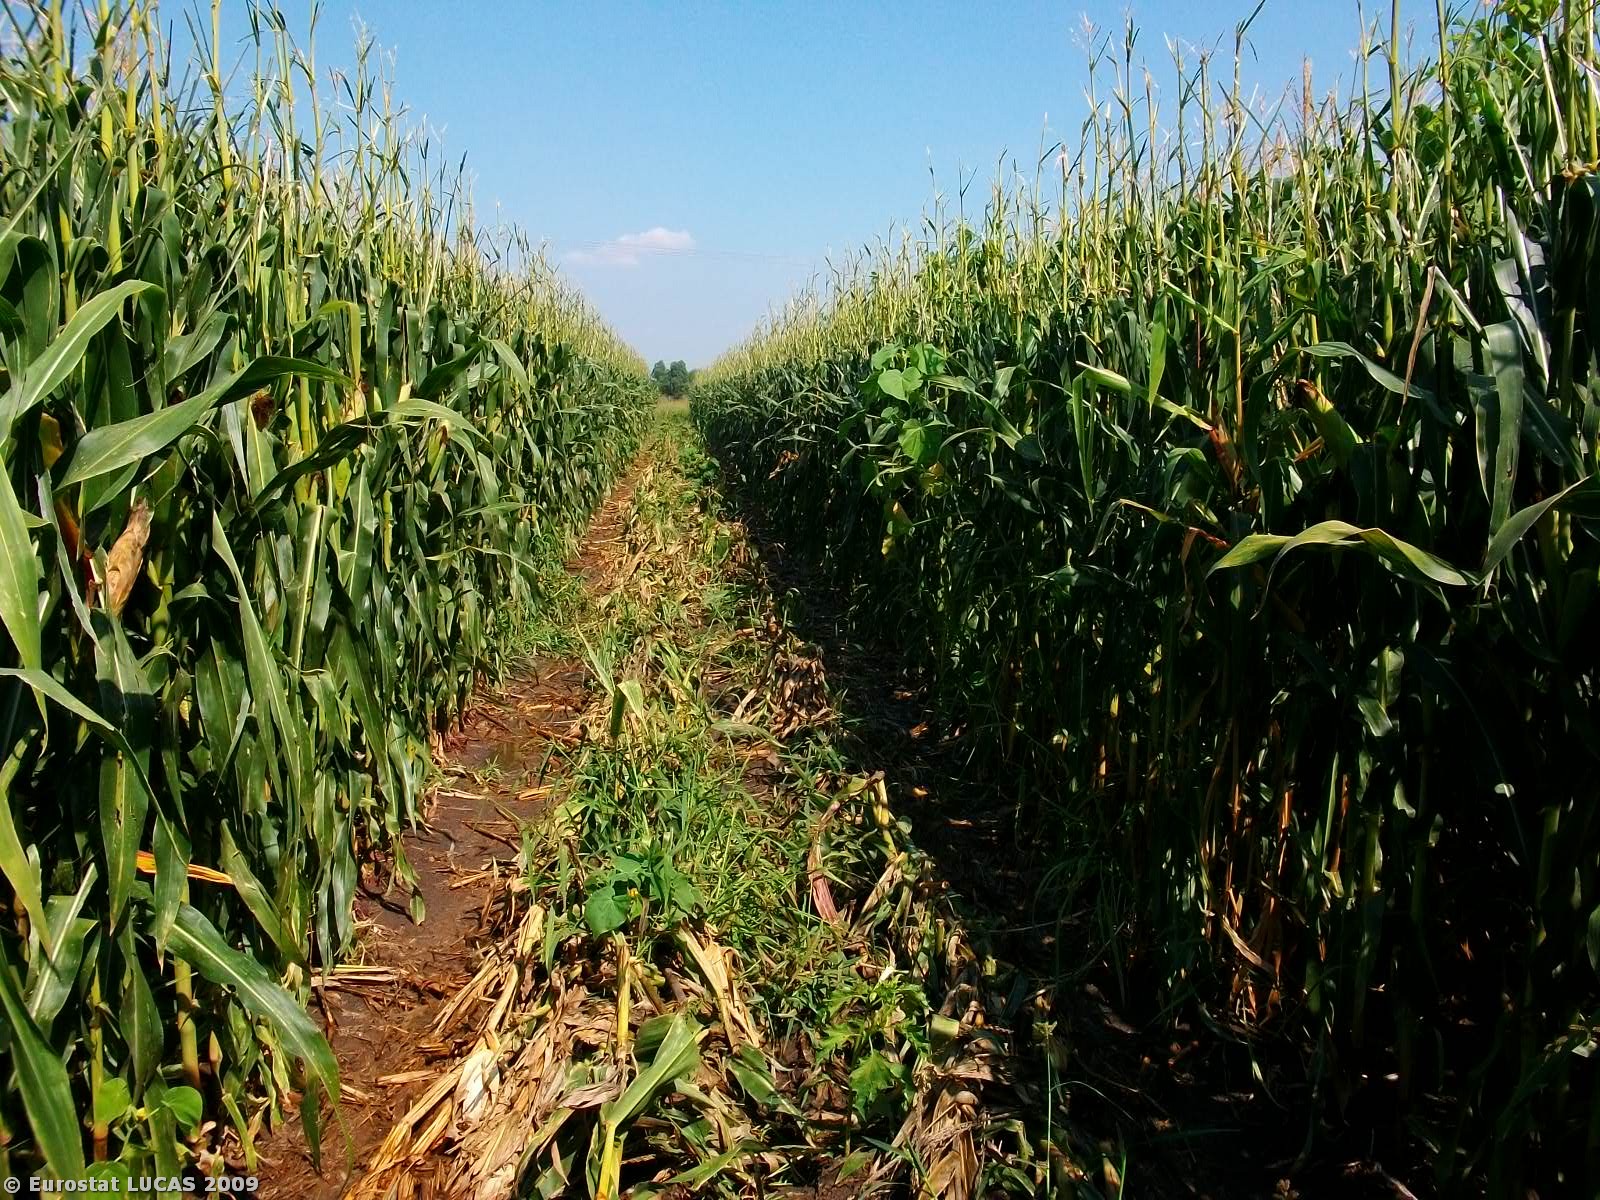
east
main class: Cropland
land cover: Maize
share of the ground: > 75 %
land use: Agriculture (excluding fallow land and kitchen gardens)
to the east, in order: Maize; Electric lines; Maize; Grass margins; Tracks; Grass margins; Spontaneously vegetated surfaces
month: August
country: GR
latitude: 41.5215
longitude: 26.4350
